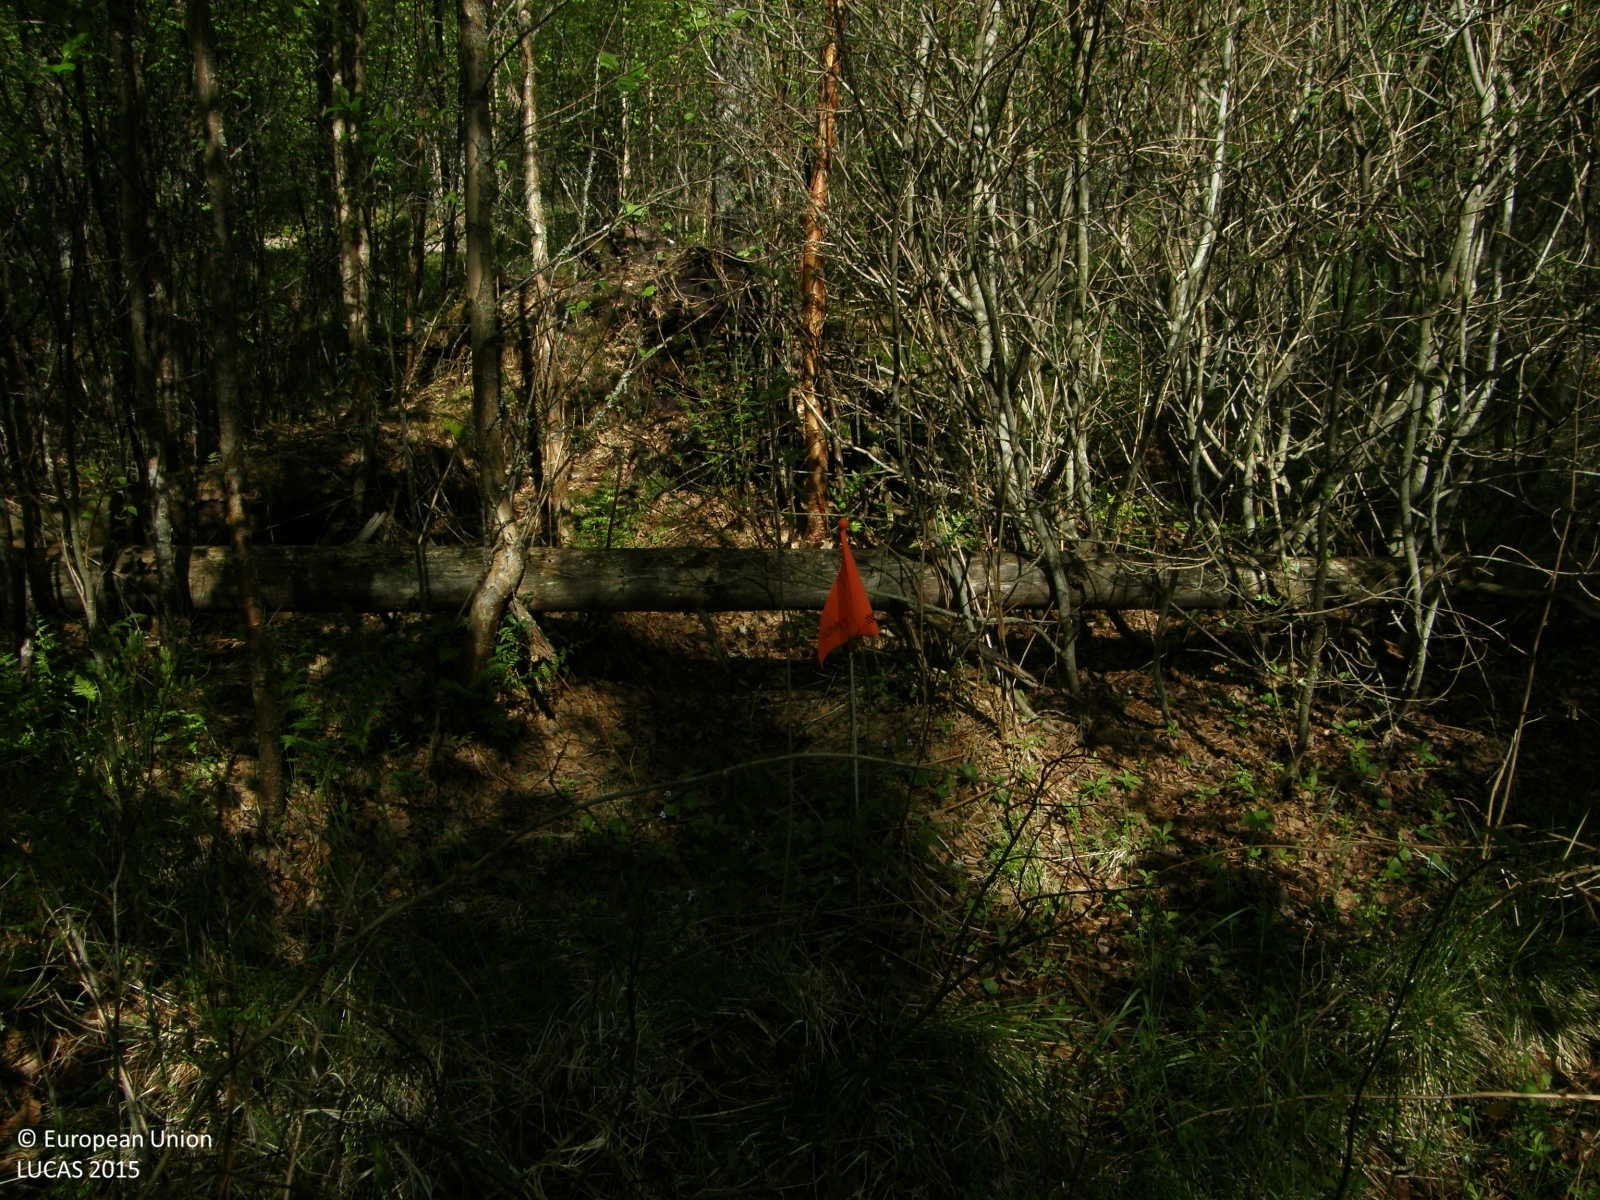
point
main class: Woodland
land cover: Pine dominated mixed woodland
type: boreal forest
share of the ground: > 75 %
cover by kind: coniferous forest trees 50 %, broadleaved forest trees 40 %, shrubs 10 %
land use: Forestry
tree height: > 5 m
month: June
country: FI
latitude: 62.1076
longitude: 21.6017
